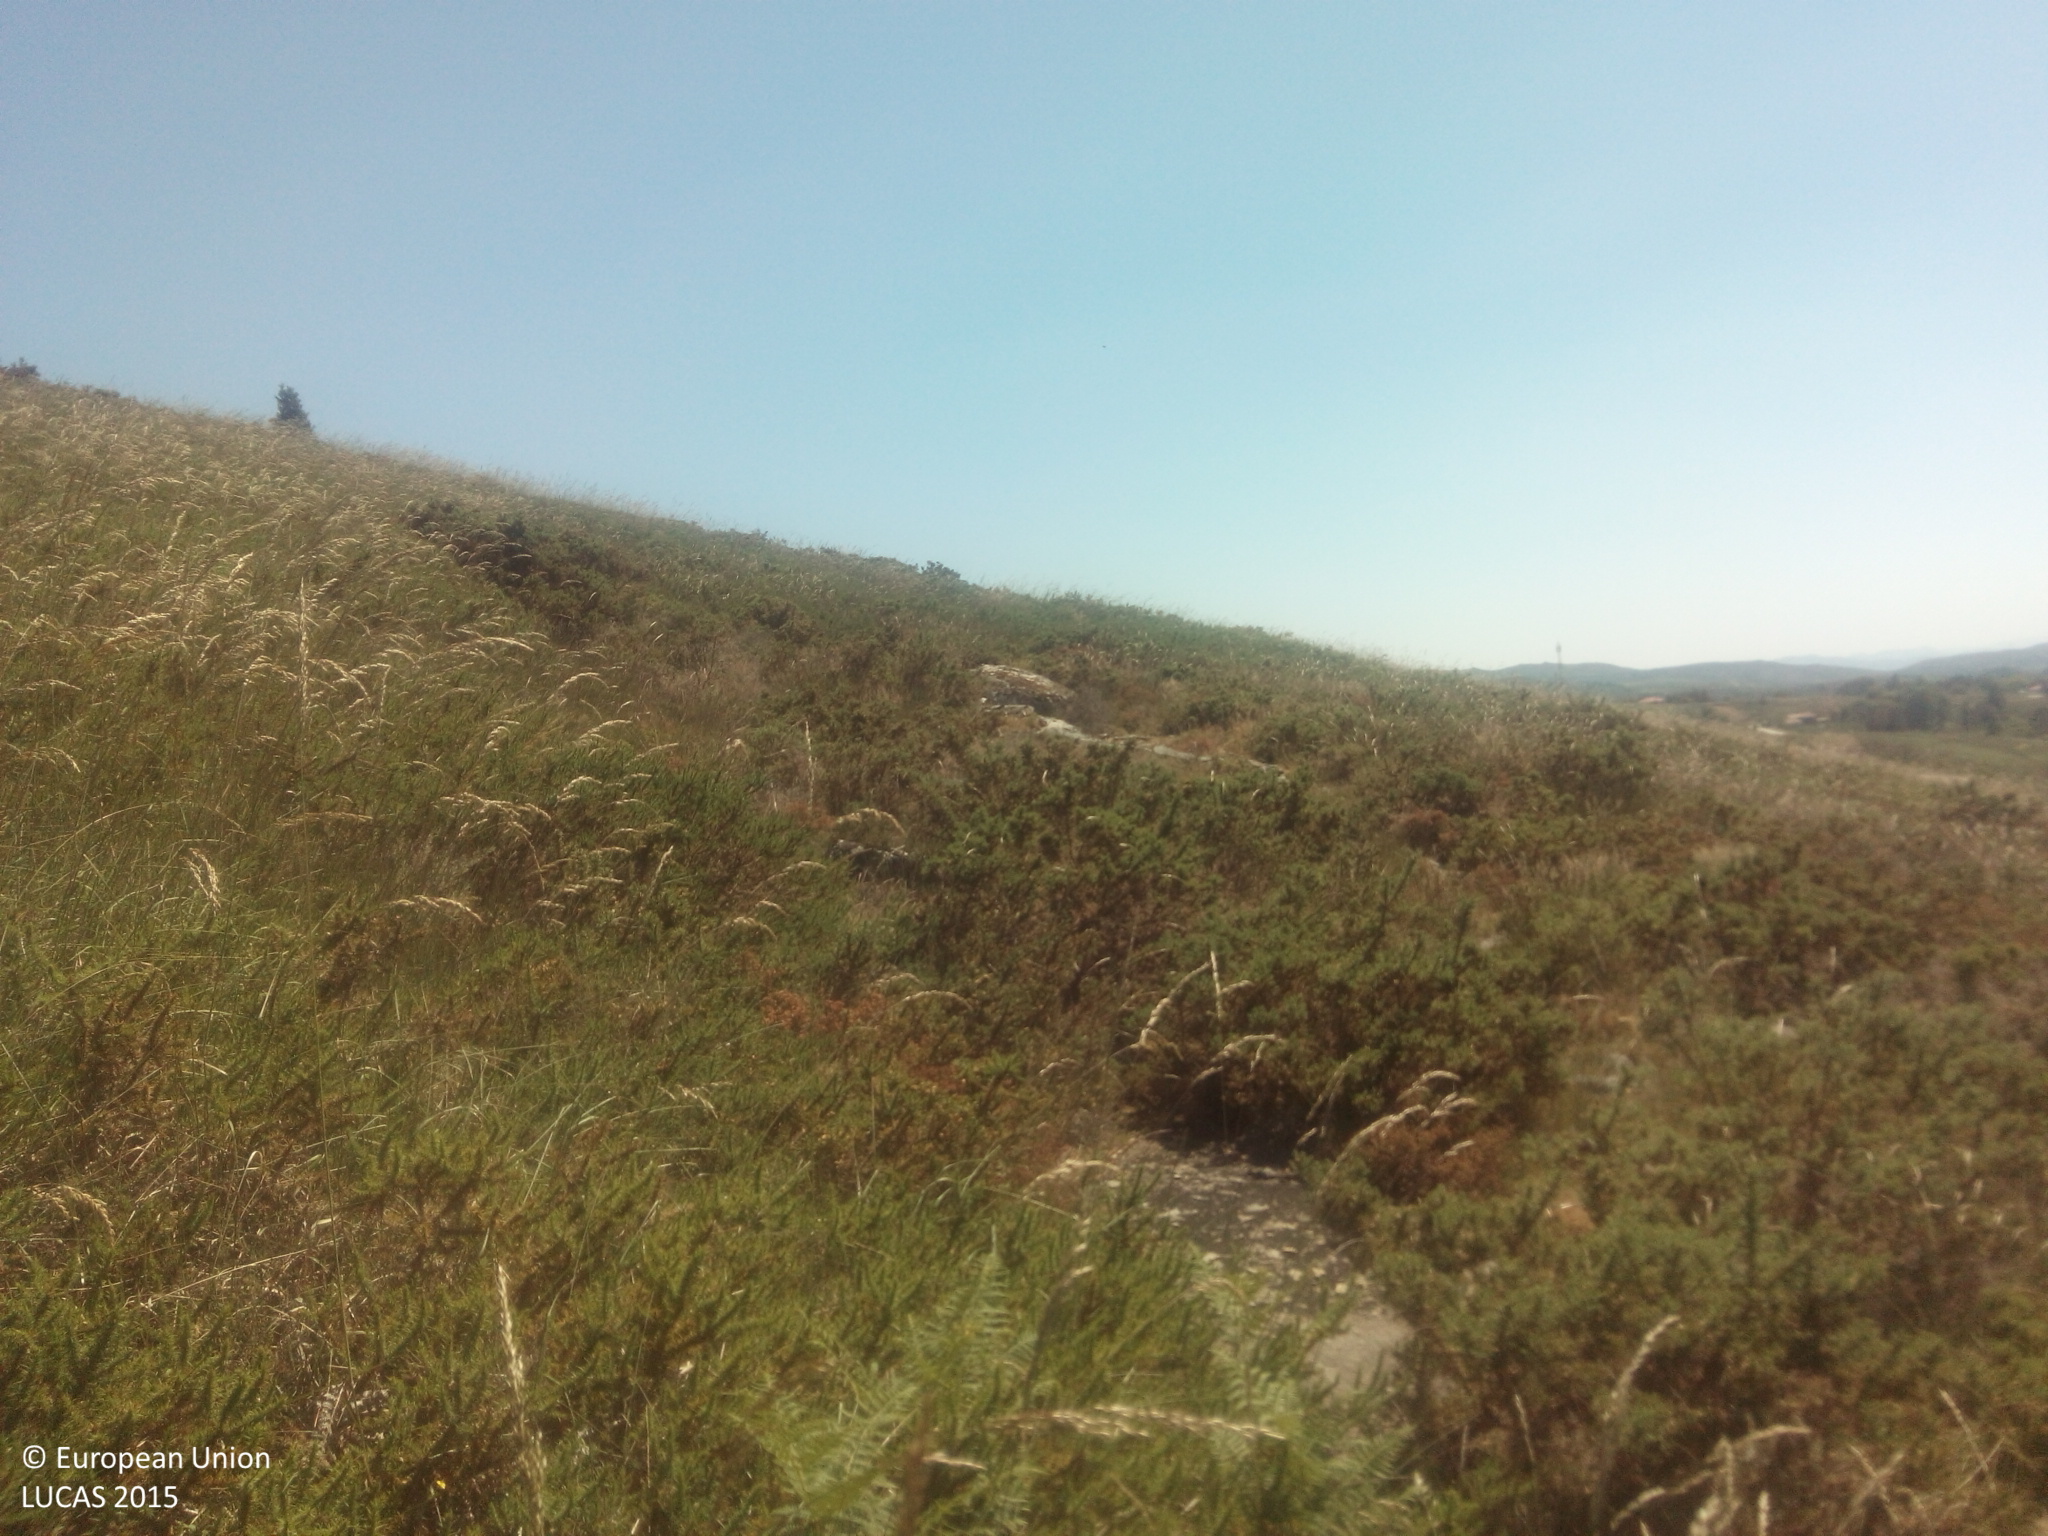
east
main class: Shrubland
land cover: Shrubland without tree cover
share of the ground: > 75 %
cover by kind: shrubs 100 %
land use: Semi-natural and natural areas not in use
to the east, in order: Shrubland without tree cover
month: June
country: ES
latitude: 42.4575
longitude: -8.3455
